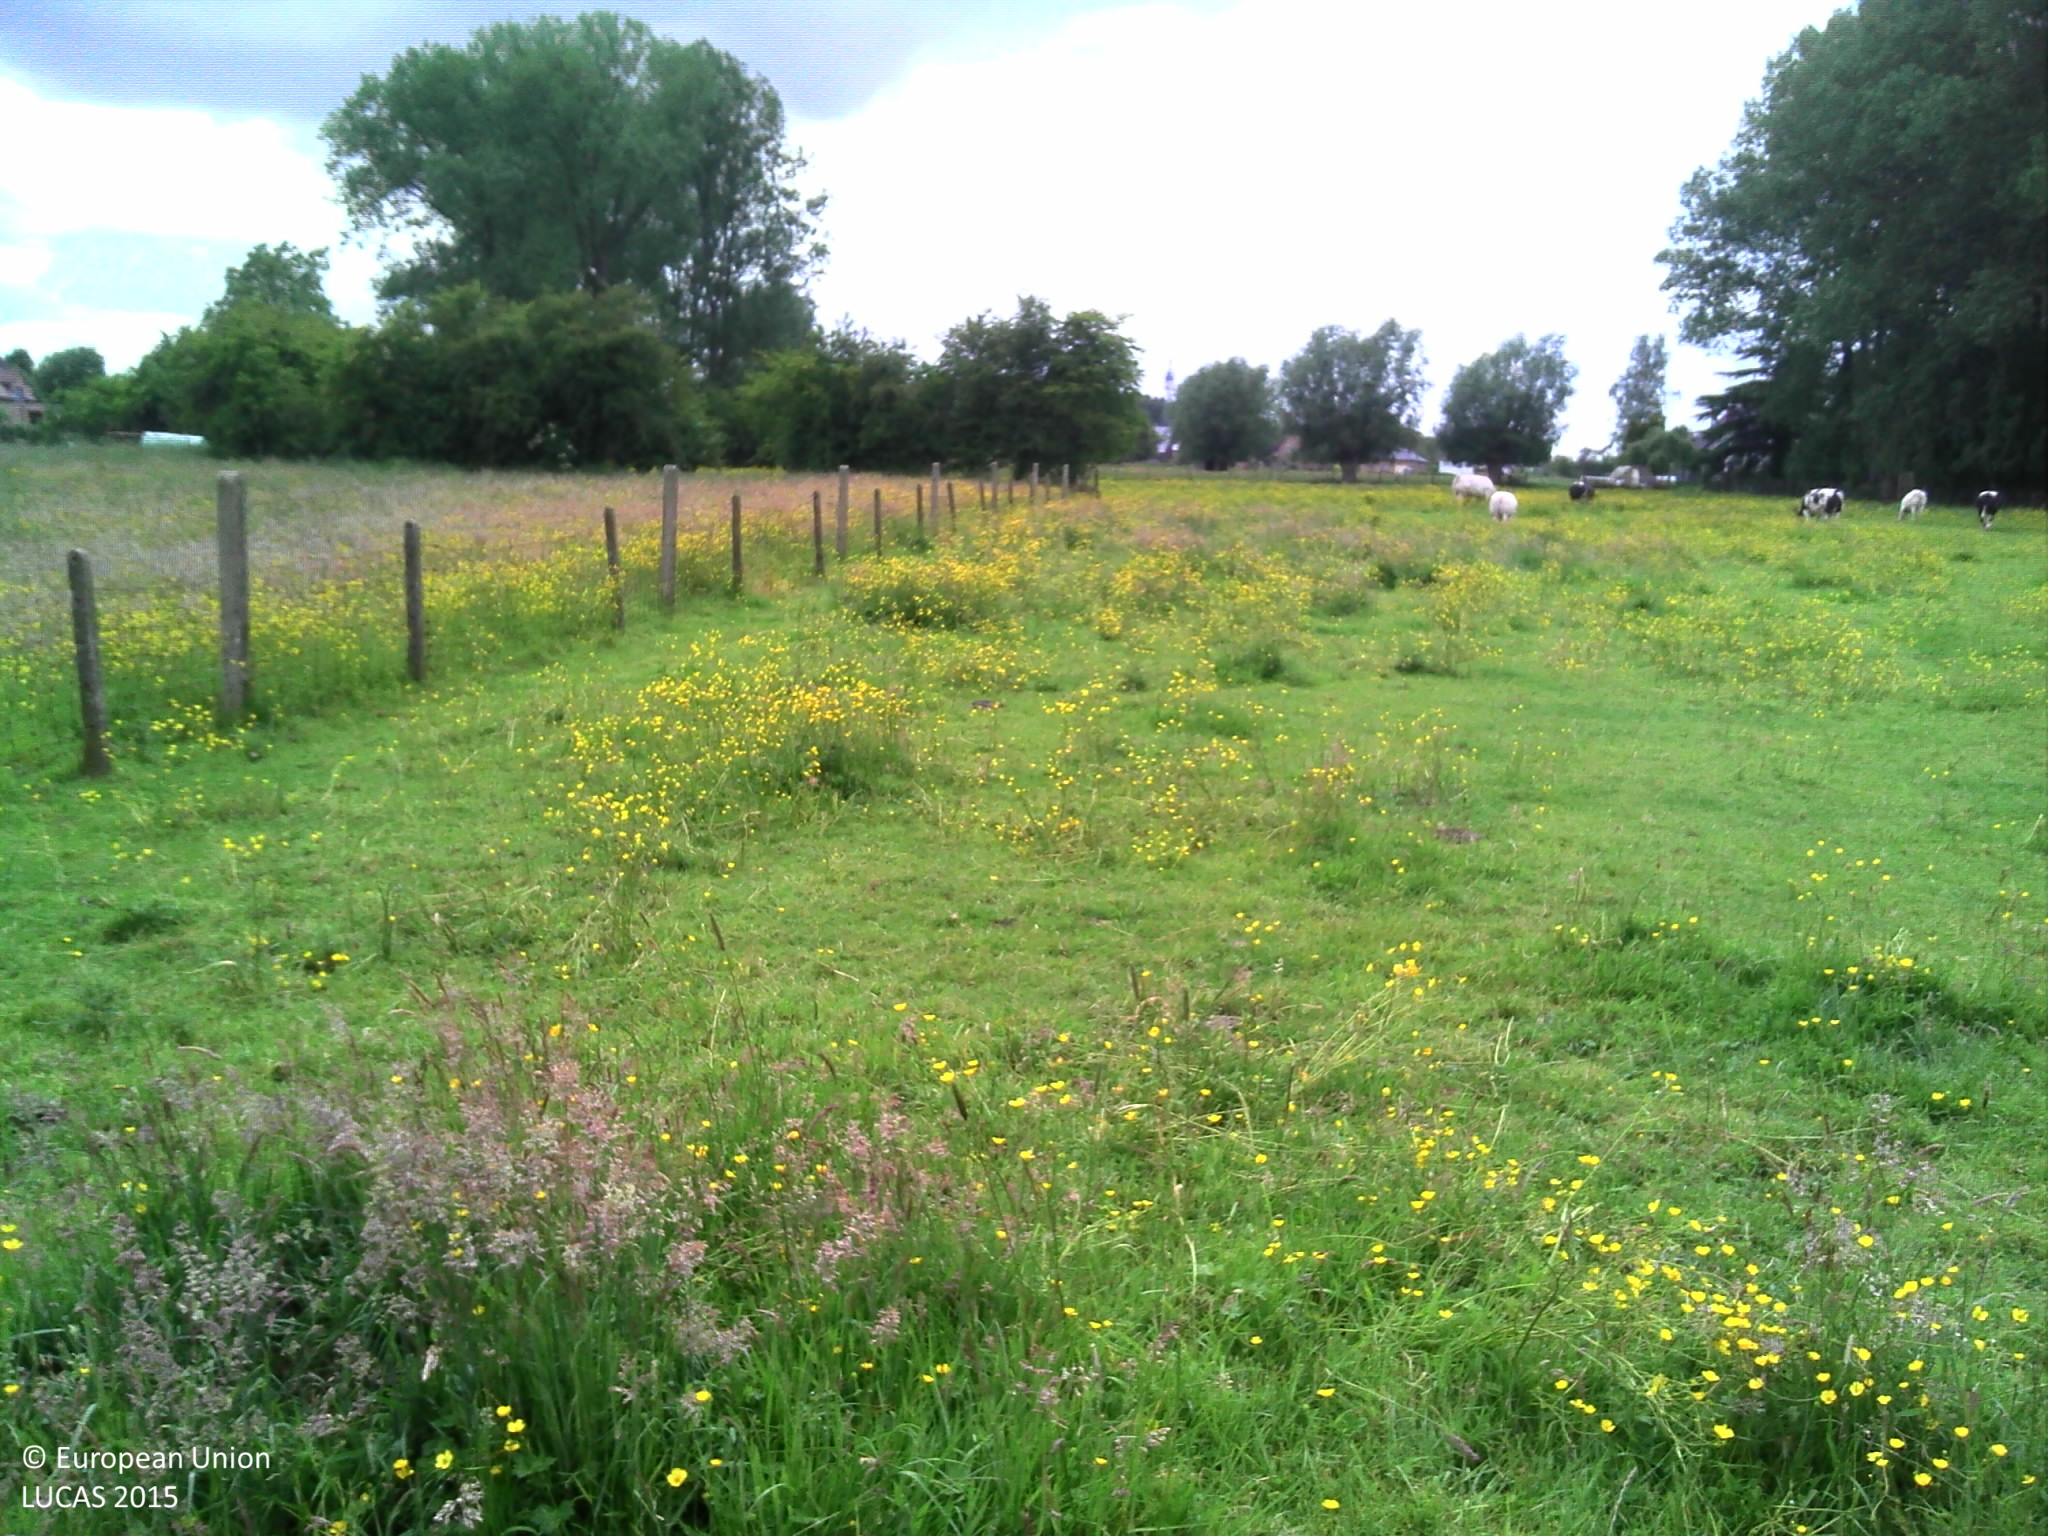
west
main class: Grassland
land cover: Grassland without tree/shrub cover
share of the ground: > 75 %
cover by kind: herbaceous plants 100 %
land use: Agriculture (excluding fallow land and kitchen gardens)
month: June
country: BE
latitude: 50.9101
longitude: 4.0066
